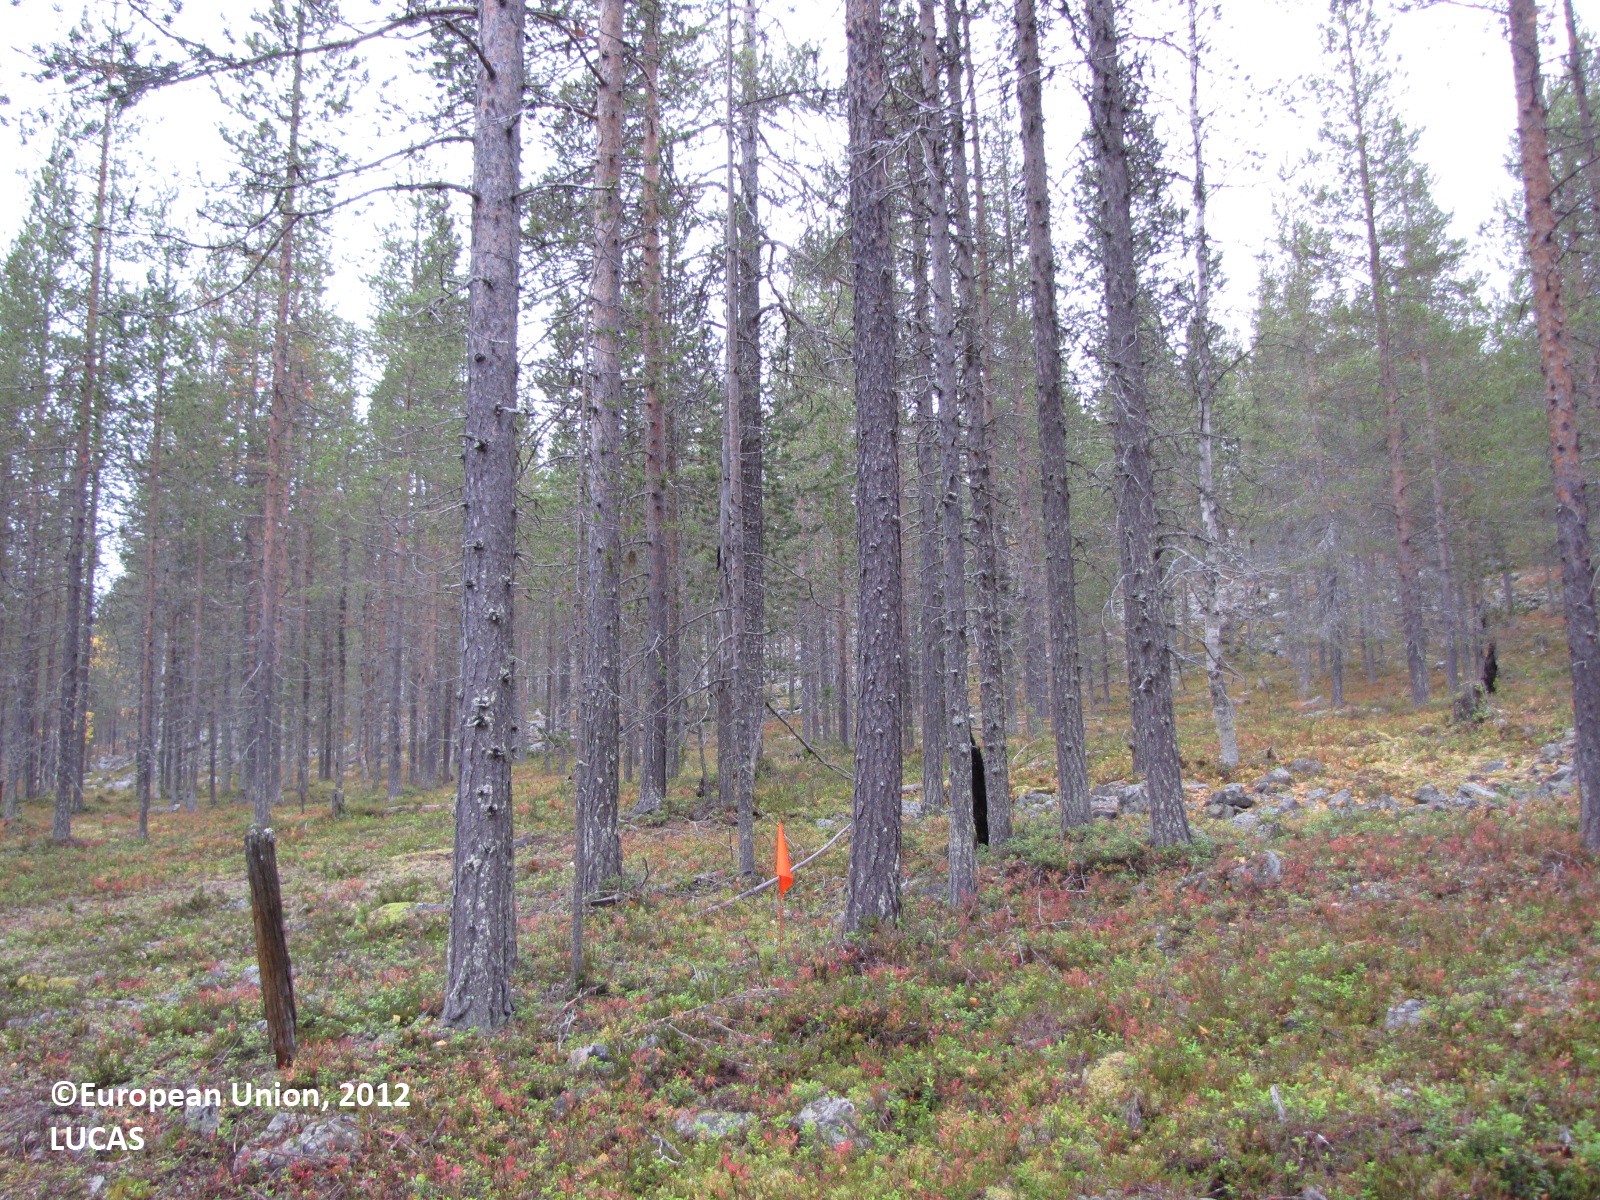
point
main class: Woodland
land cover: Pine dominated coniferous woodland
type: boreal forest
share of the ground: 25 - 50 %
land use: Forestry
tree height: > 5 m
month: September
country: FI
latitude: 67.5868
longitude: 24.0534
